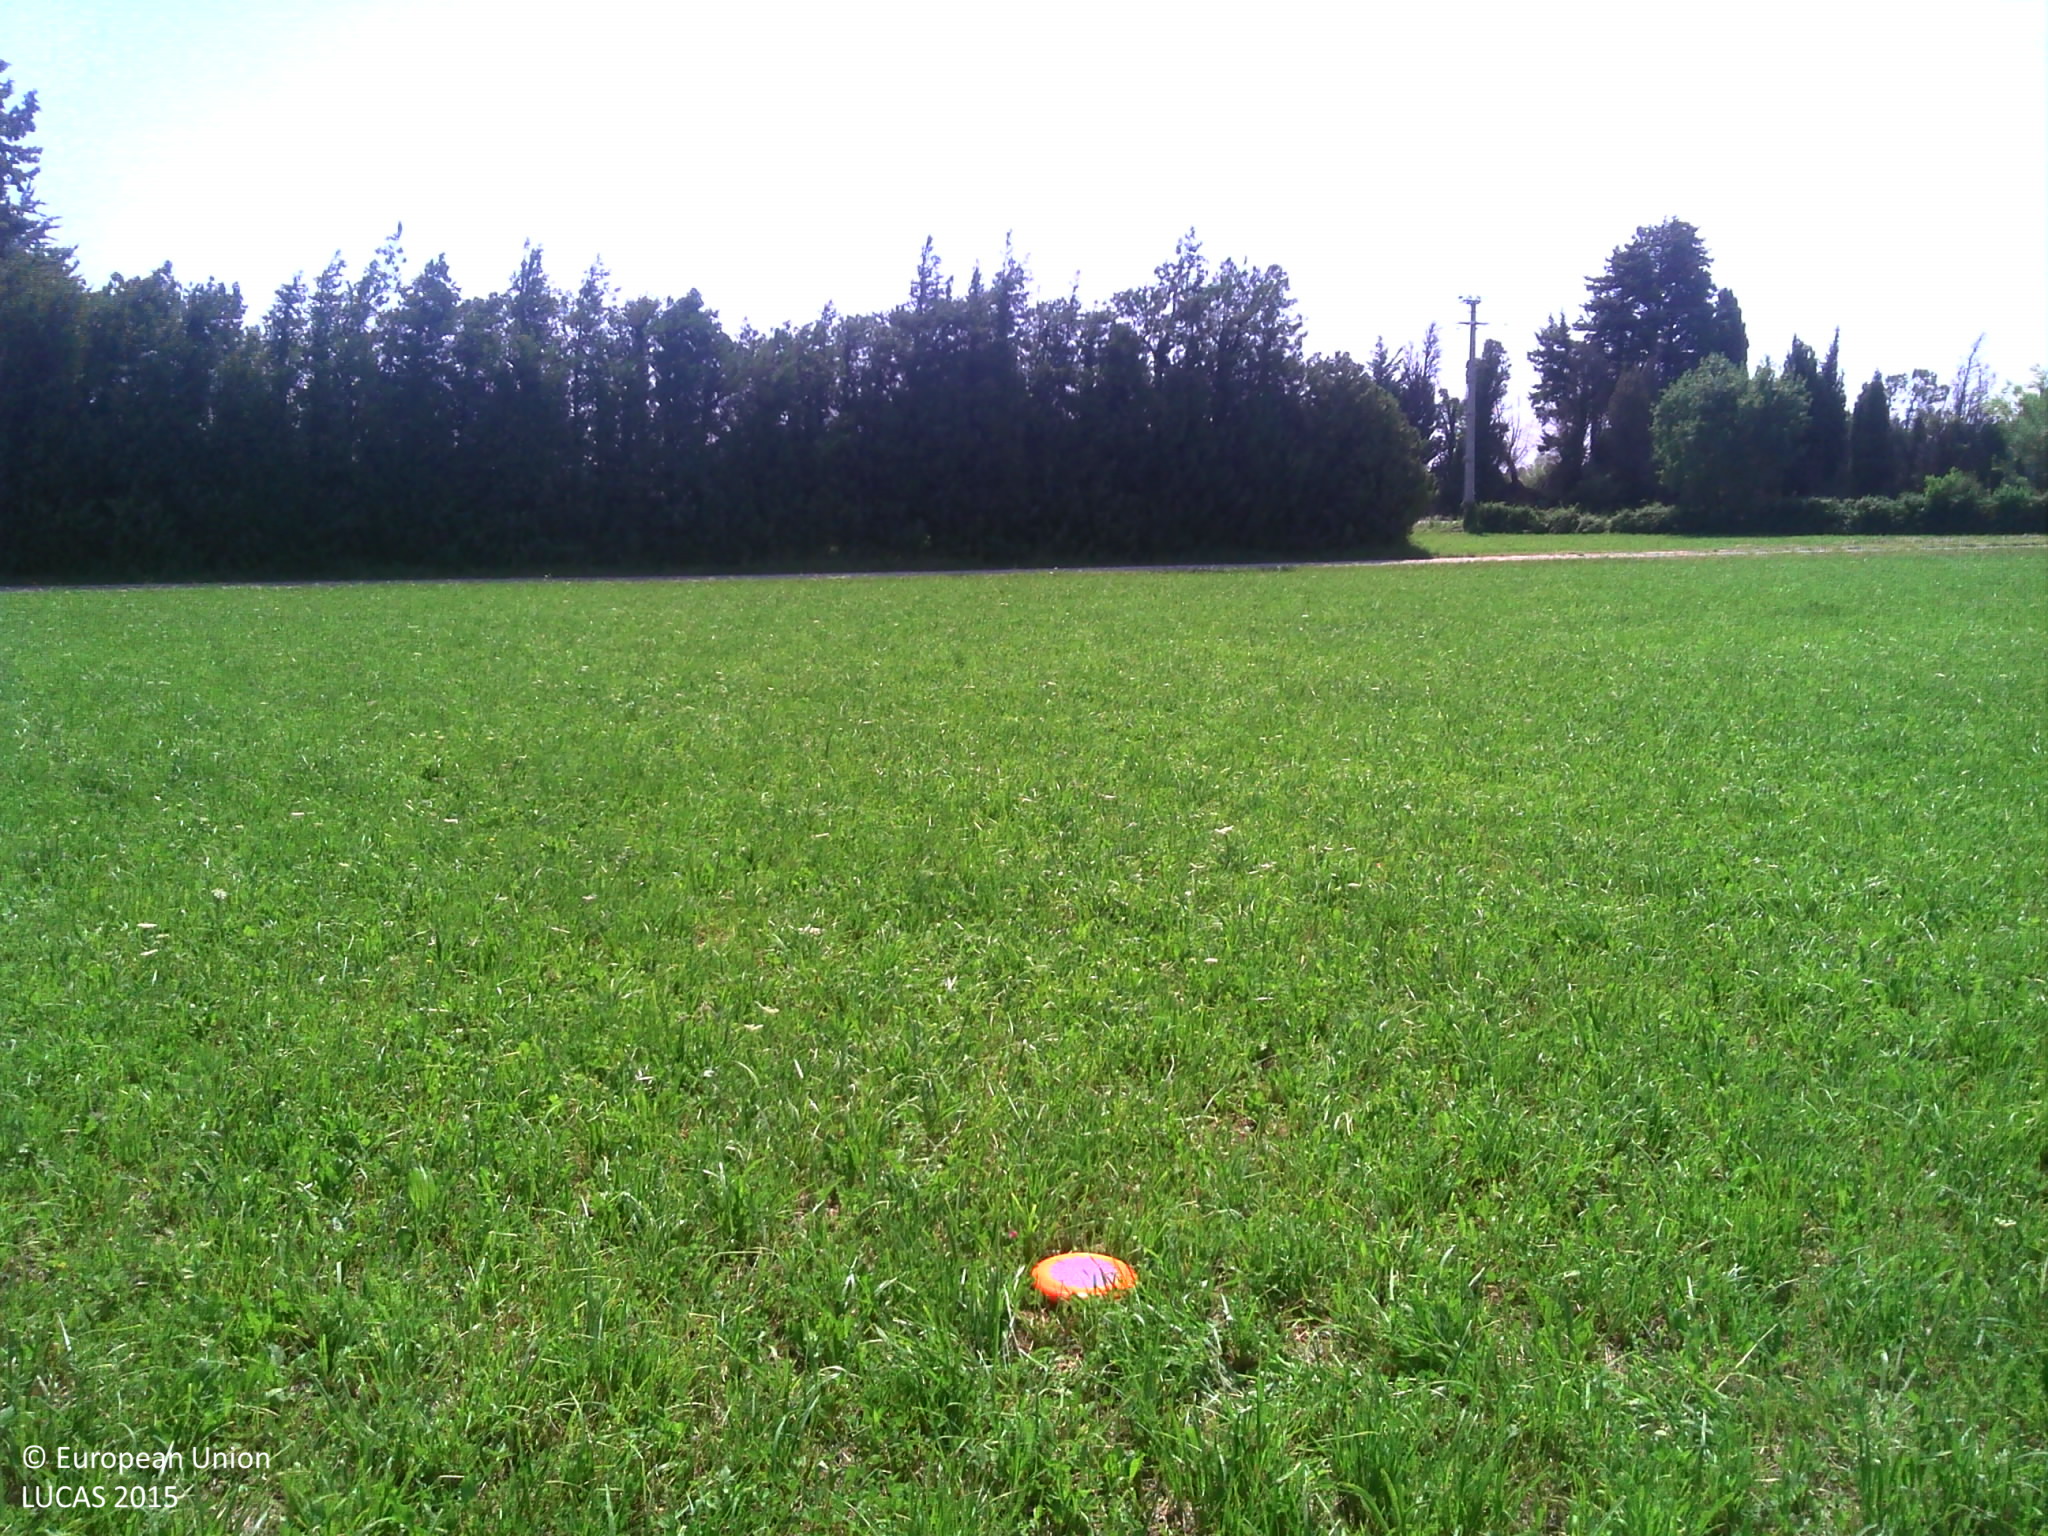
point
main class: Grassland
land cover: Grassland without tree/shrub cover
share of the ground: > 75 %
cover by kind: herbaceous plants 100 %
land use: Agriculture (excluding fallow land and kitchen gardens)
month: July
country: FR
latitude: 43.6367
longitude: 5.0637
